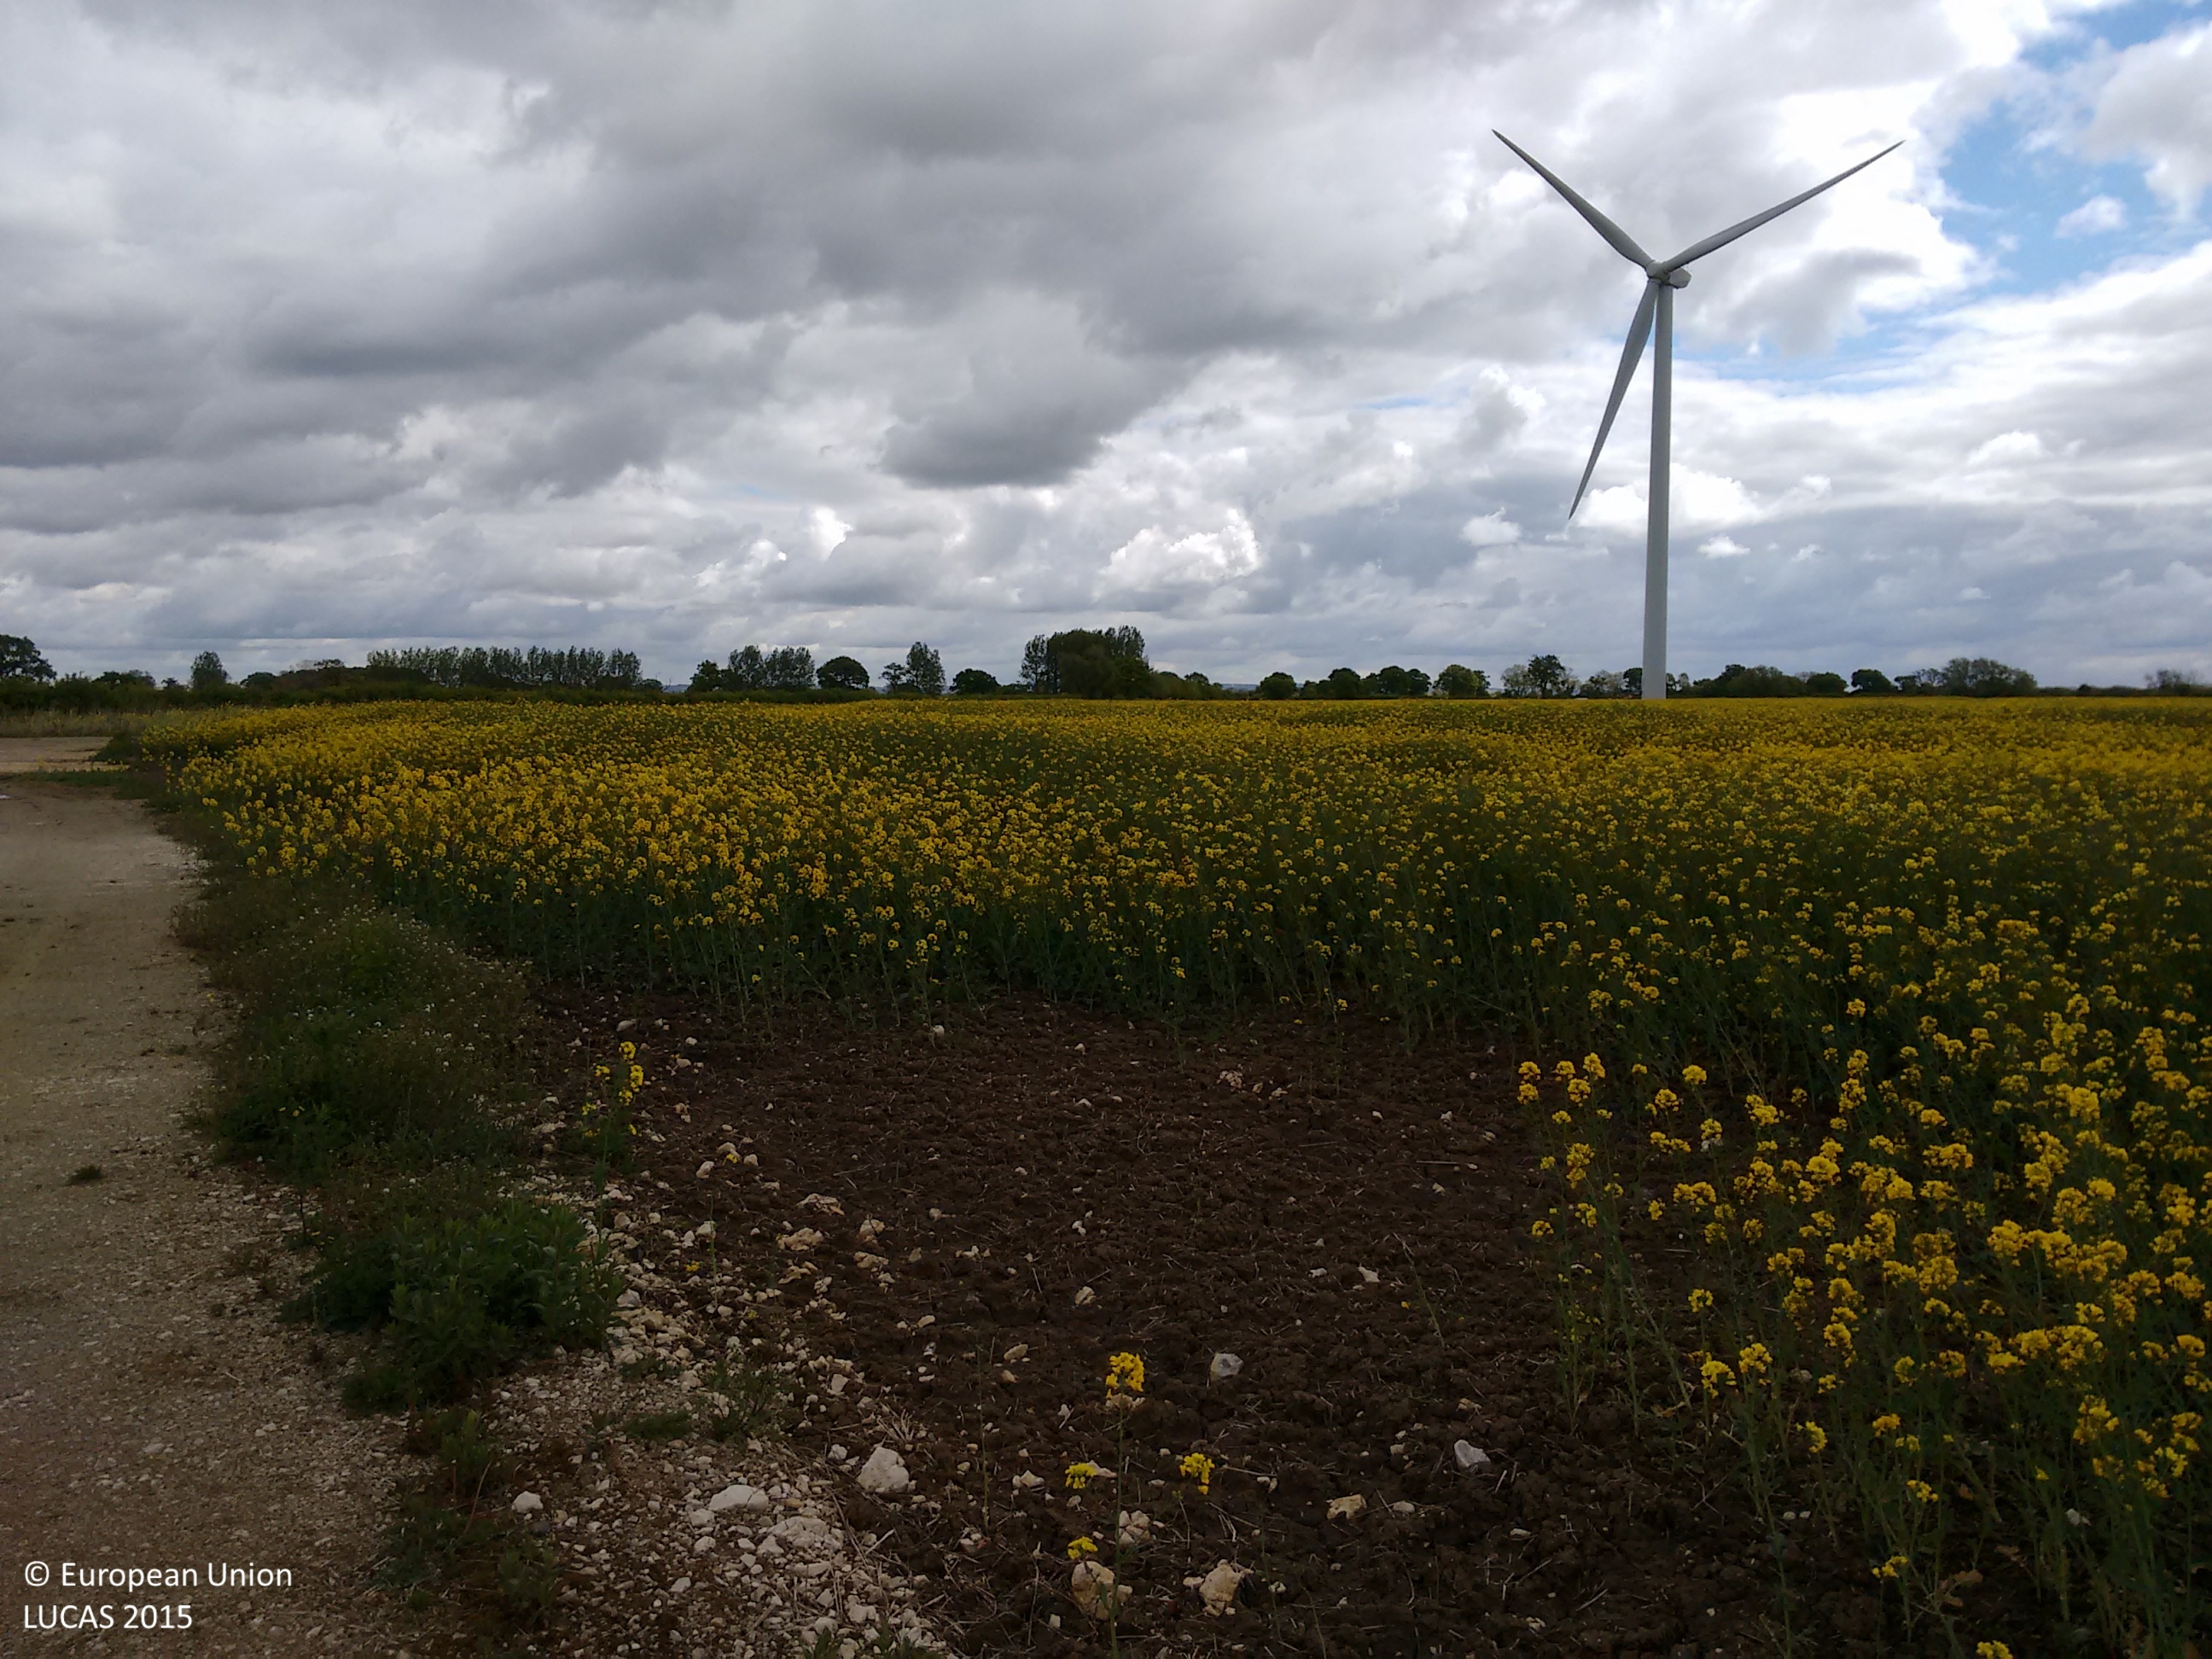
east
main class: Cropland
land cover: Rape and turnip rape
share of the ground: > 75 %
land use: Agriculture (excluding fallow land and kitchen gardens)
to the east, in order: Rape and turnip rape
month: May
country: GB
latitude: 53.7350
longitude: -0.7884
